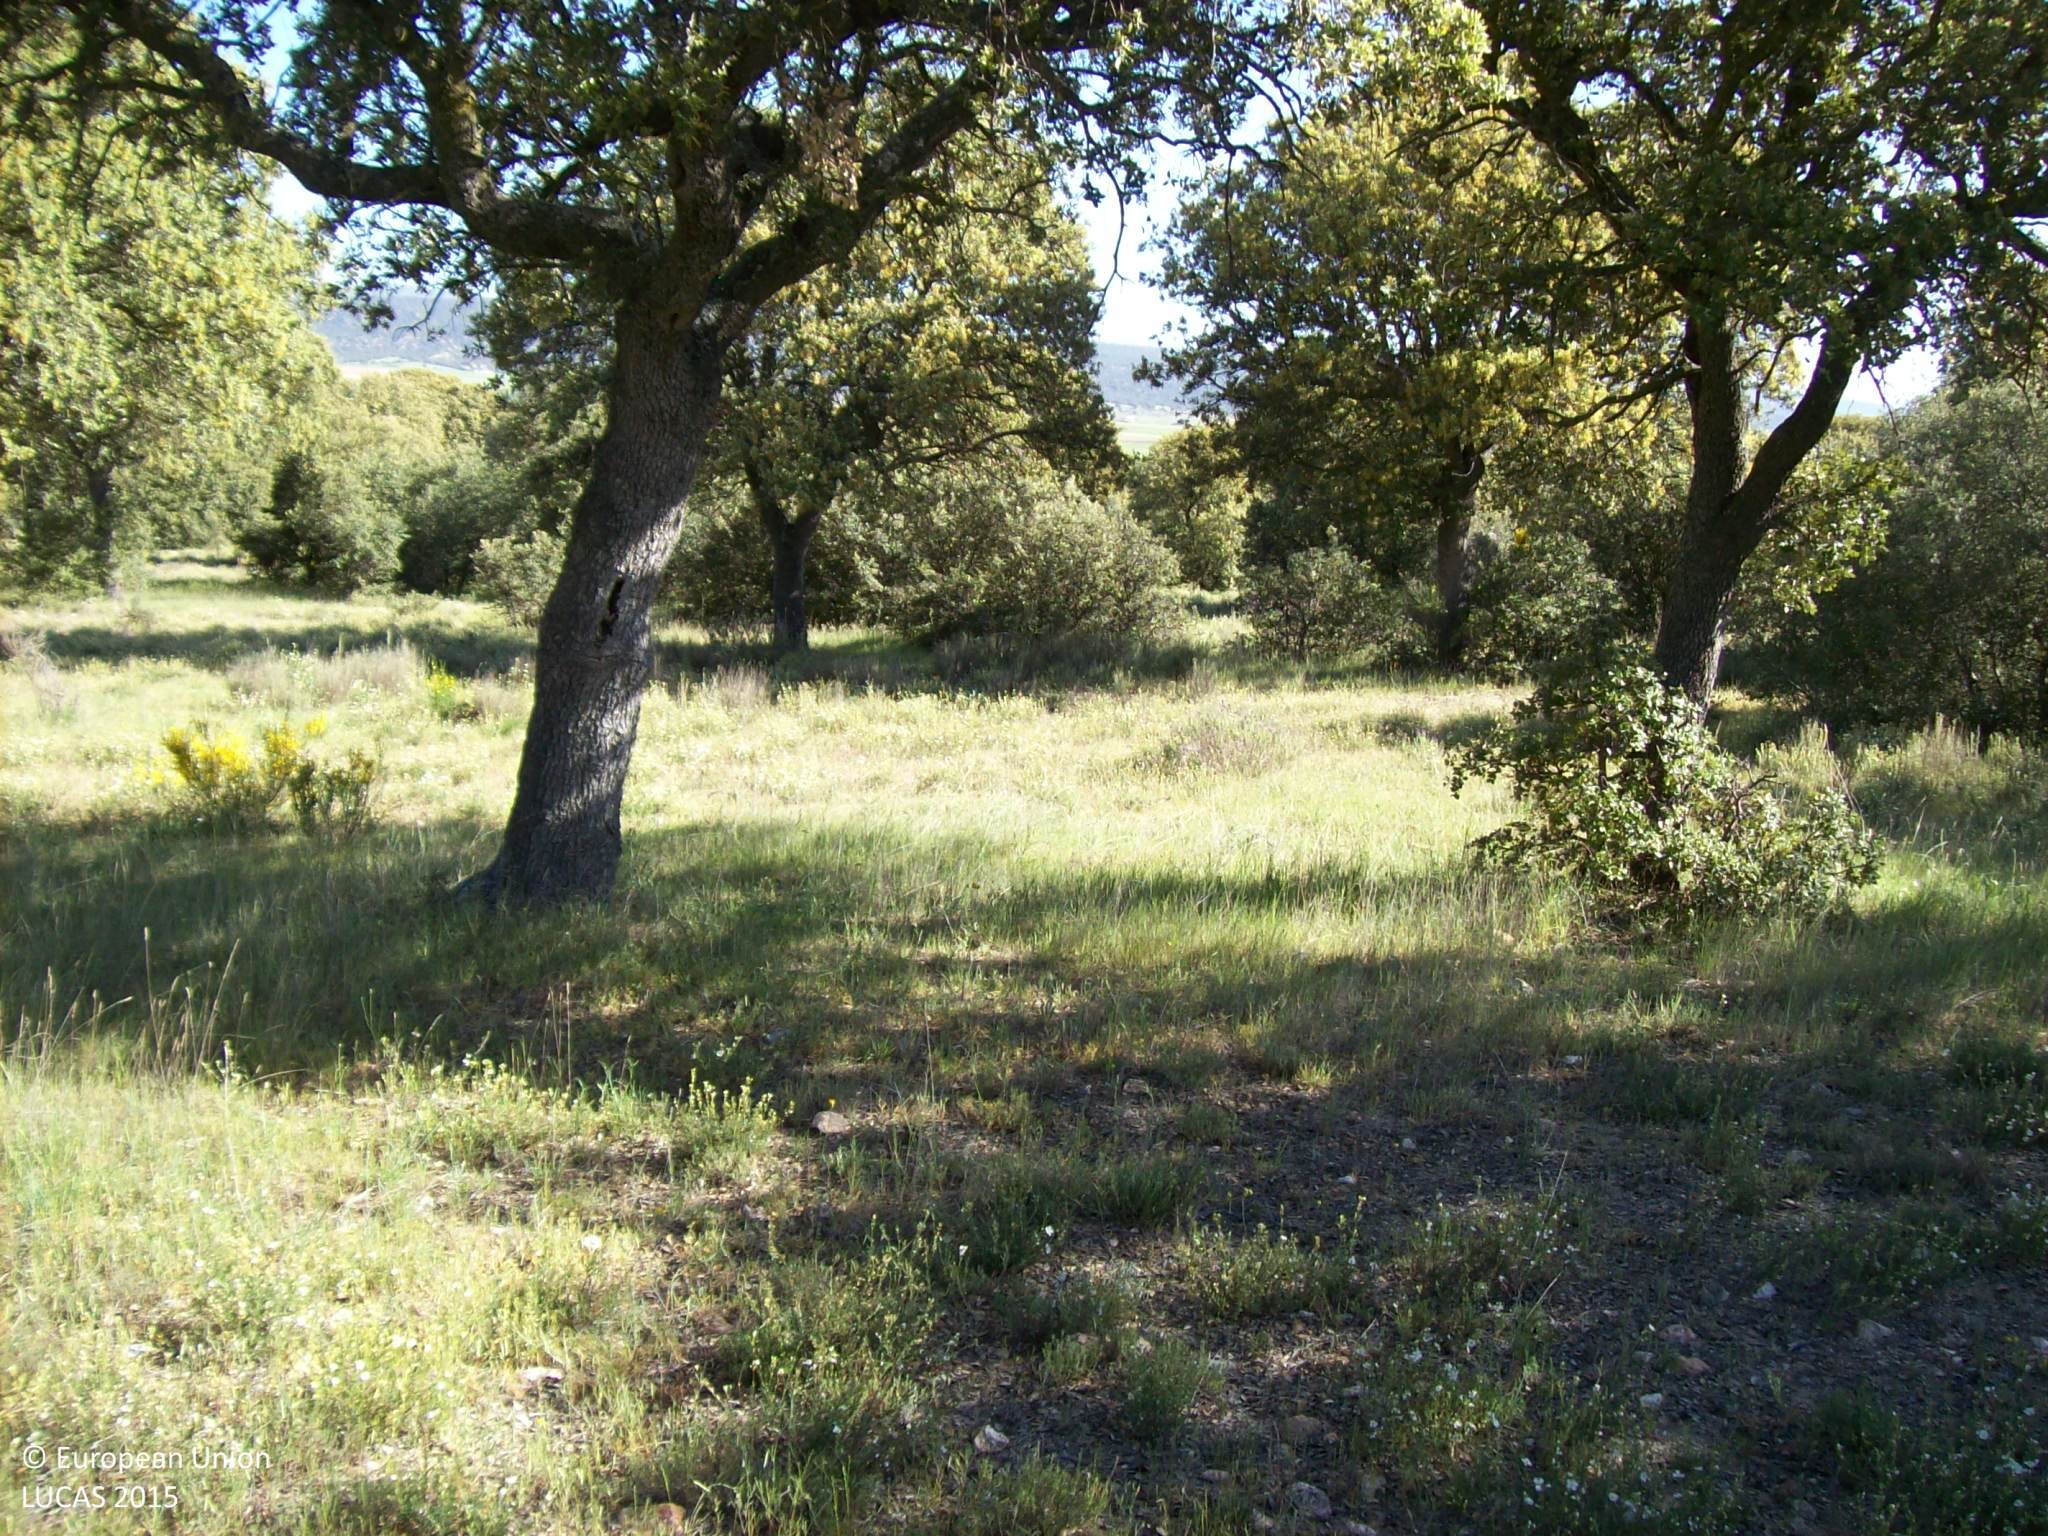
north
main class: Woodland
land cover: Broadleaved woodland
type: broadleaved evergreen forest
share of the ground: 25 - 50 %
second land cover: Grassland without tree/shrub cover
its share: 50 - 75 %
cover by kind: herbaceous plants 65 %, broadleaved forest trees 30 %, shrubs 5 %
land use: Forestry
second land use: Agriculture (excluding fallow land and kitchen gardens)
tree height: > 5 m
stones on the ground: 10 - 25 %
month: May
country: ES
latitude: 40.5682
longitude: -4.9291
